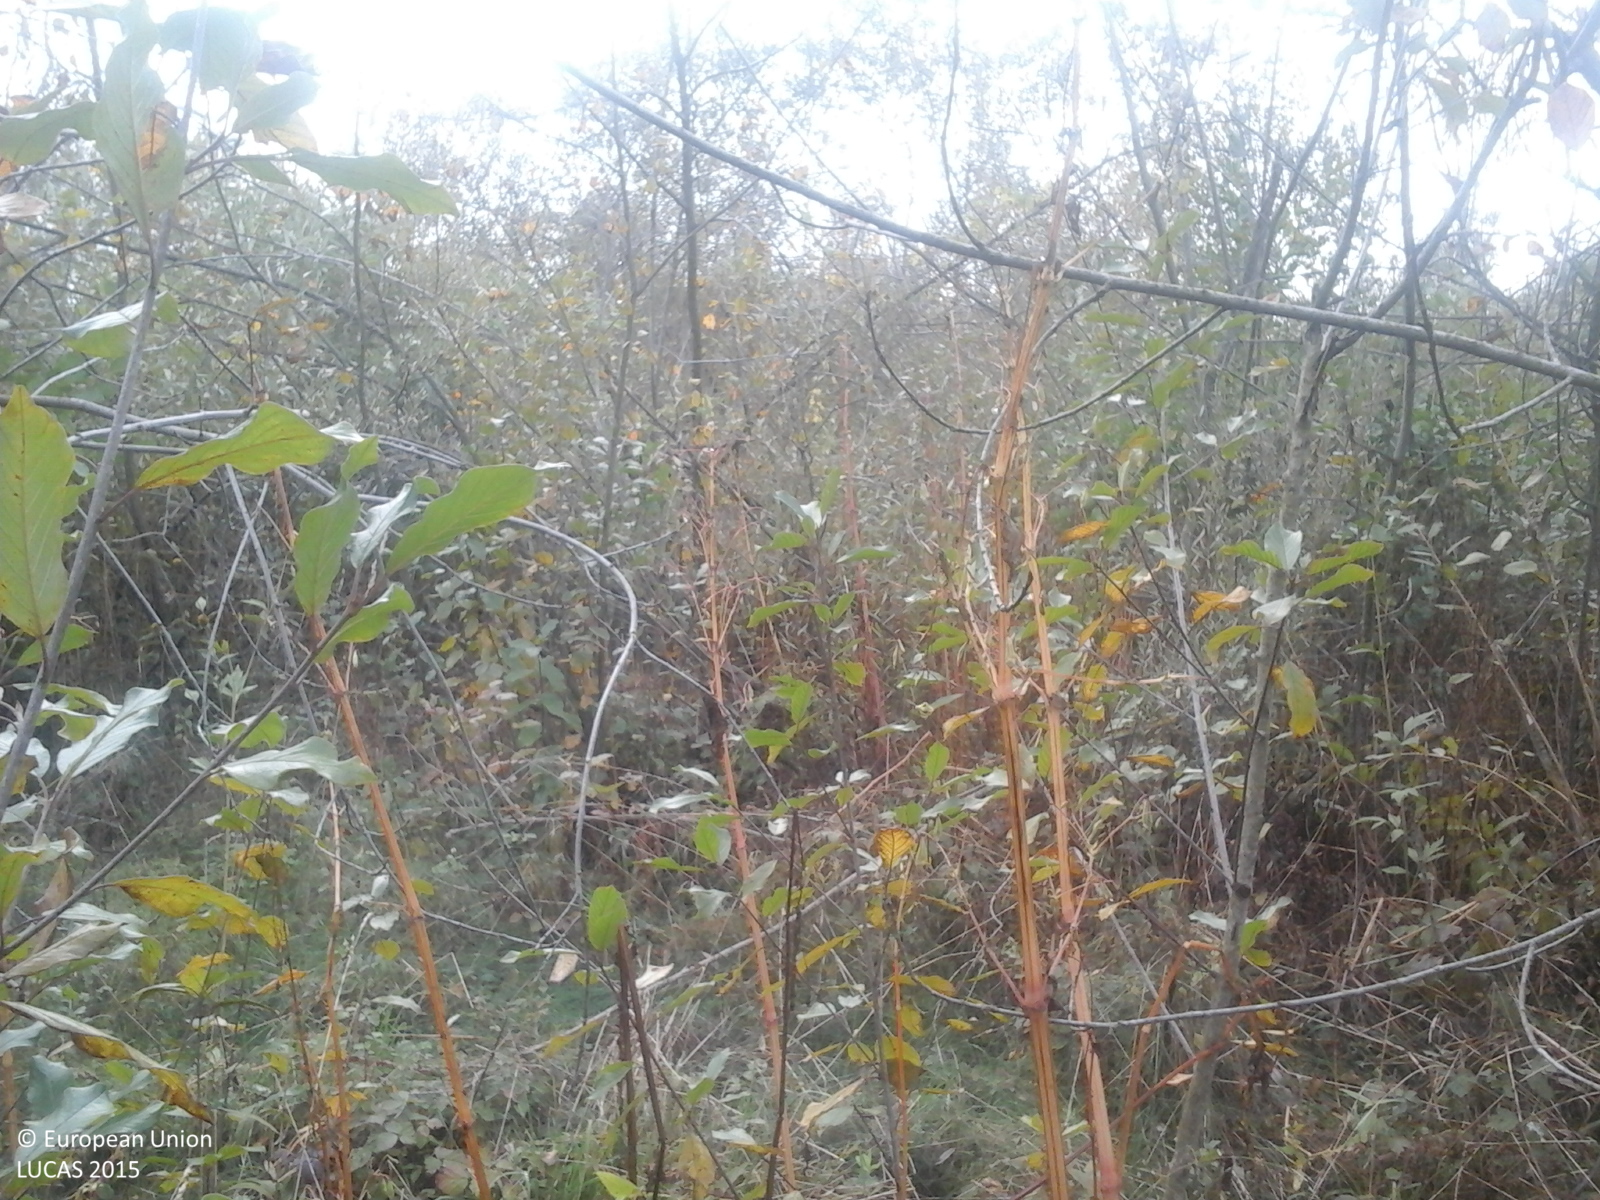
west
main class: Woodland
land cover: Broadleaved woodland
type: floodplain forest
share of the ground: > 75 %
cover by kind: broadleaved forest trees 100 %
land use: Forestry
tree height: > 5 m
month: October
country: RO
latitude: 45.7492
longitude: 24.8323
